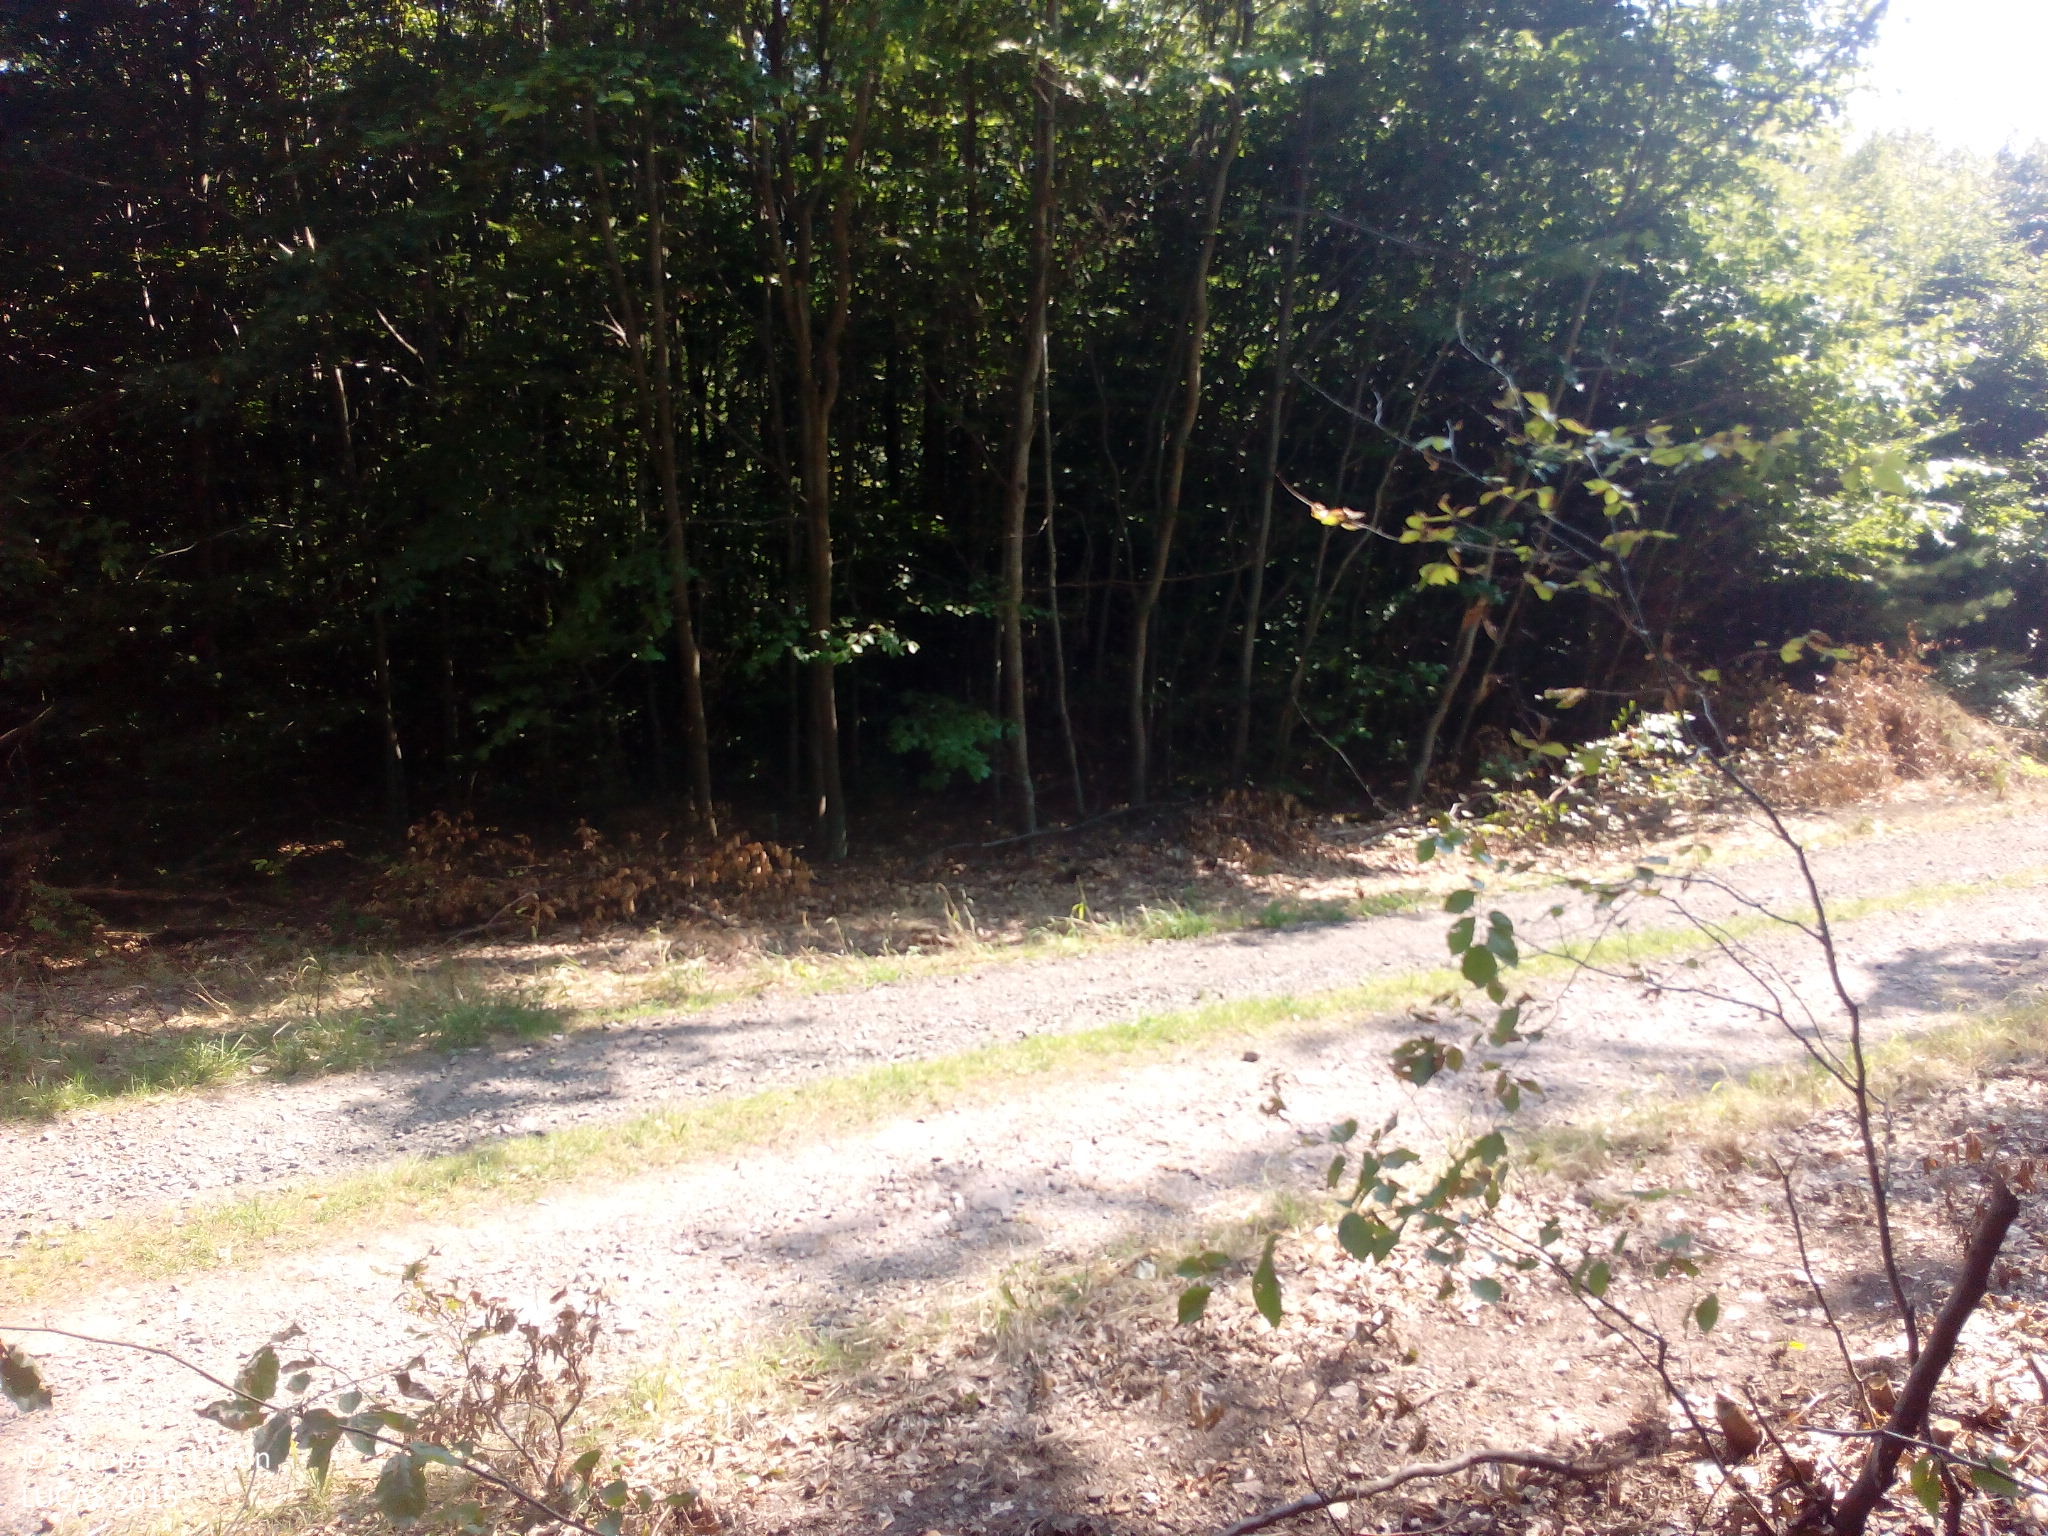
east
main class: Woodland
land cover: Broadleaved woodland
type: beech forest
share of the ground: > 75 %
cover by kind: broadleaved forest trees 90 %, consolidated bare surface 10 %
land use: Forestry
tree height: > 5 m
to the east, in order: Broadleaved woodland; Tracks; Broadleaved woodland; Tracks; Broadleaved woodland; Other mixed woodland
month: August
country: DE
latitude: 49.7614
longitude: 7.5154
